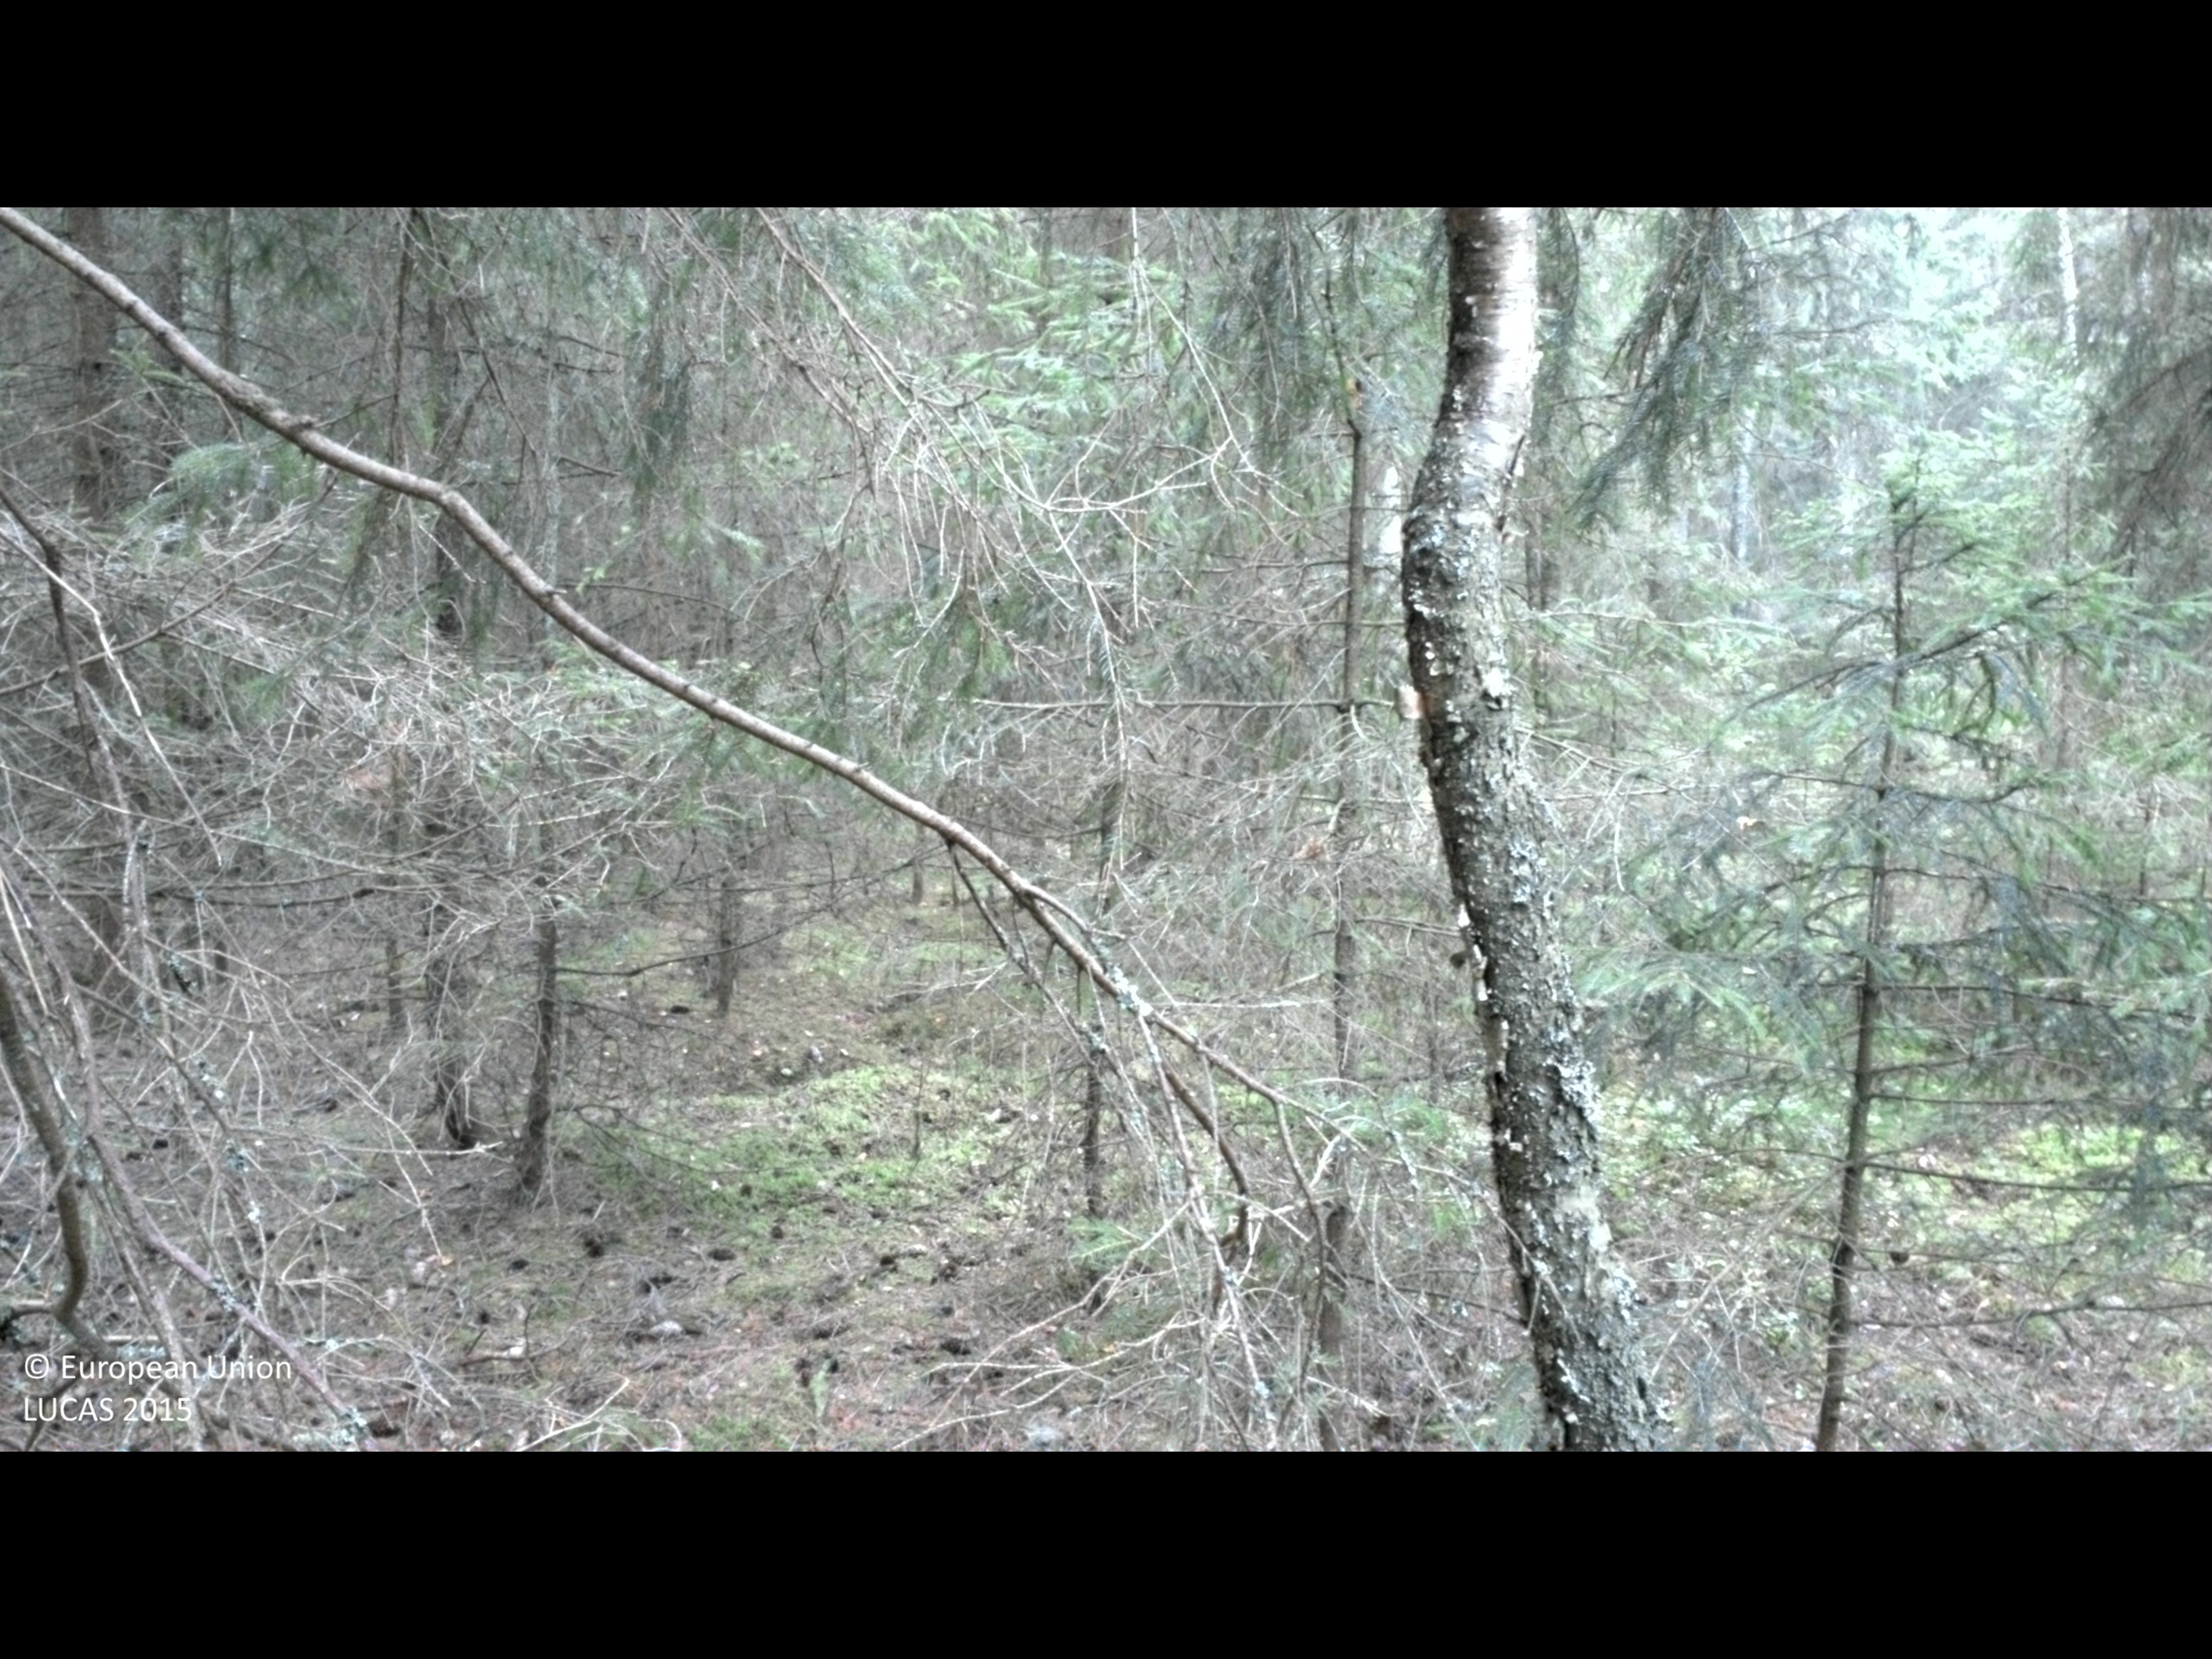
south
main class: Woodland
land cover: Spruce dominated coniferous woodland
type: boreal forest
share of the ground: > 75 %
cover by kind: coniferous forest trees 75 %, shrubs 15 %, broadleaved forest trees 5 %, lichens and mosses 5 %
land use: Forestry
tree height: > 5 m
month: August
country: SE
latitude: 56.9404
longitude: 13.1687
